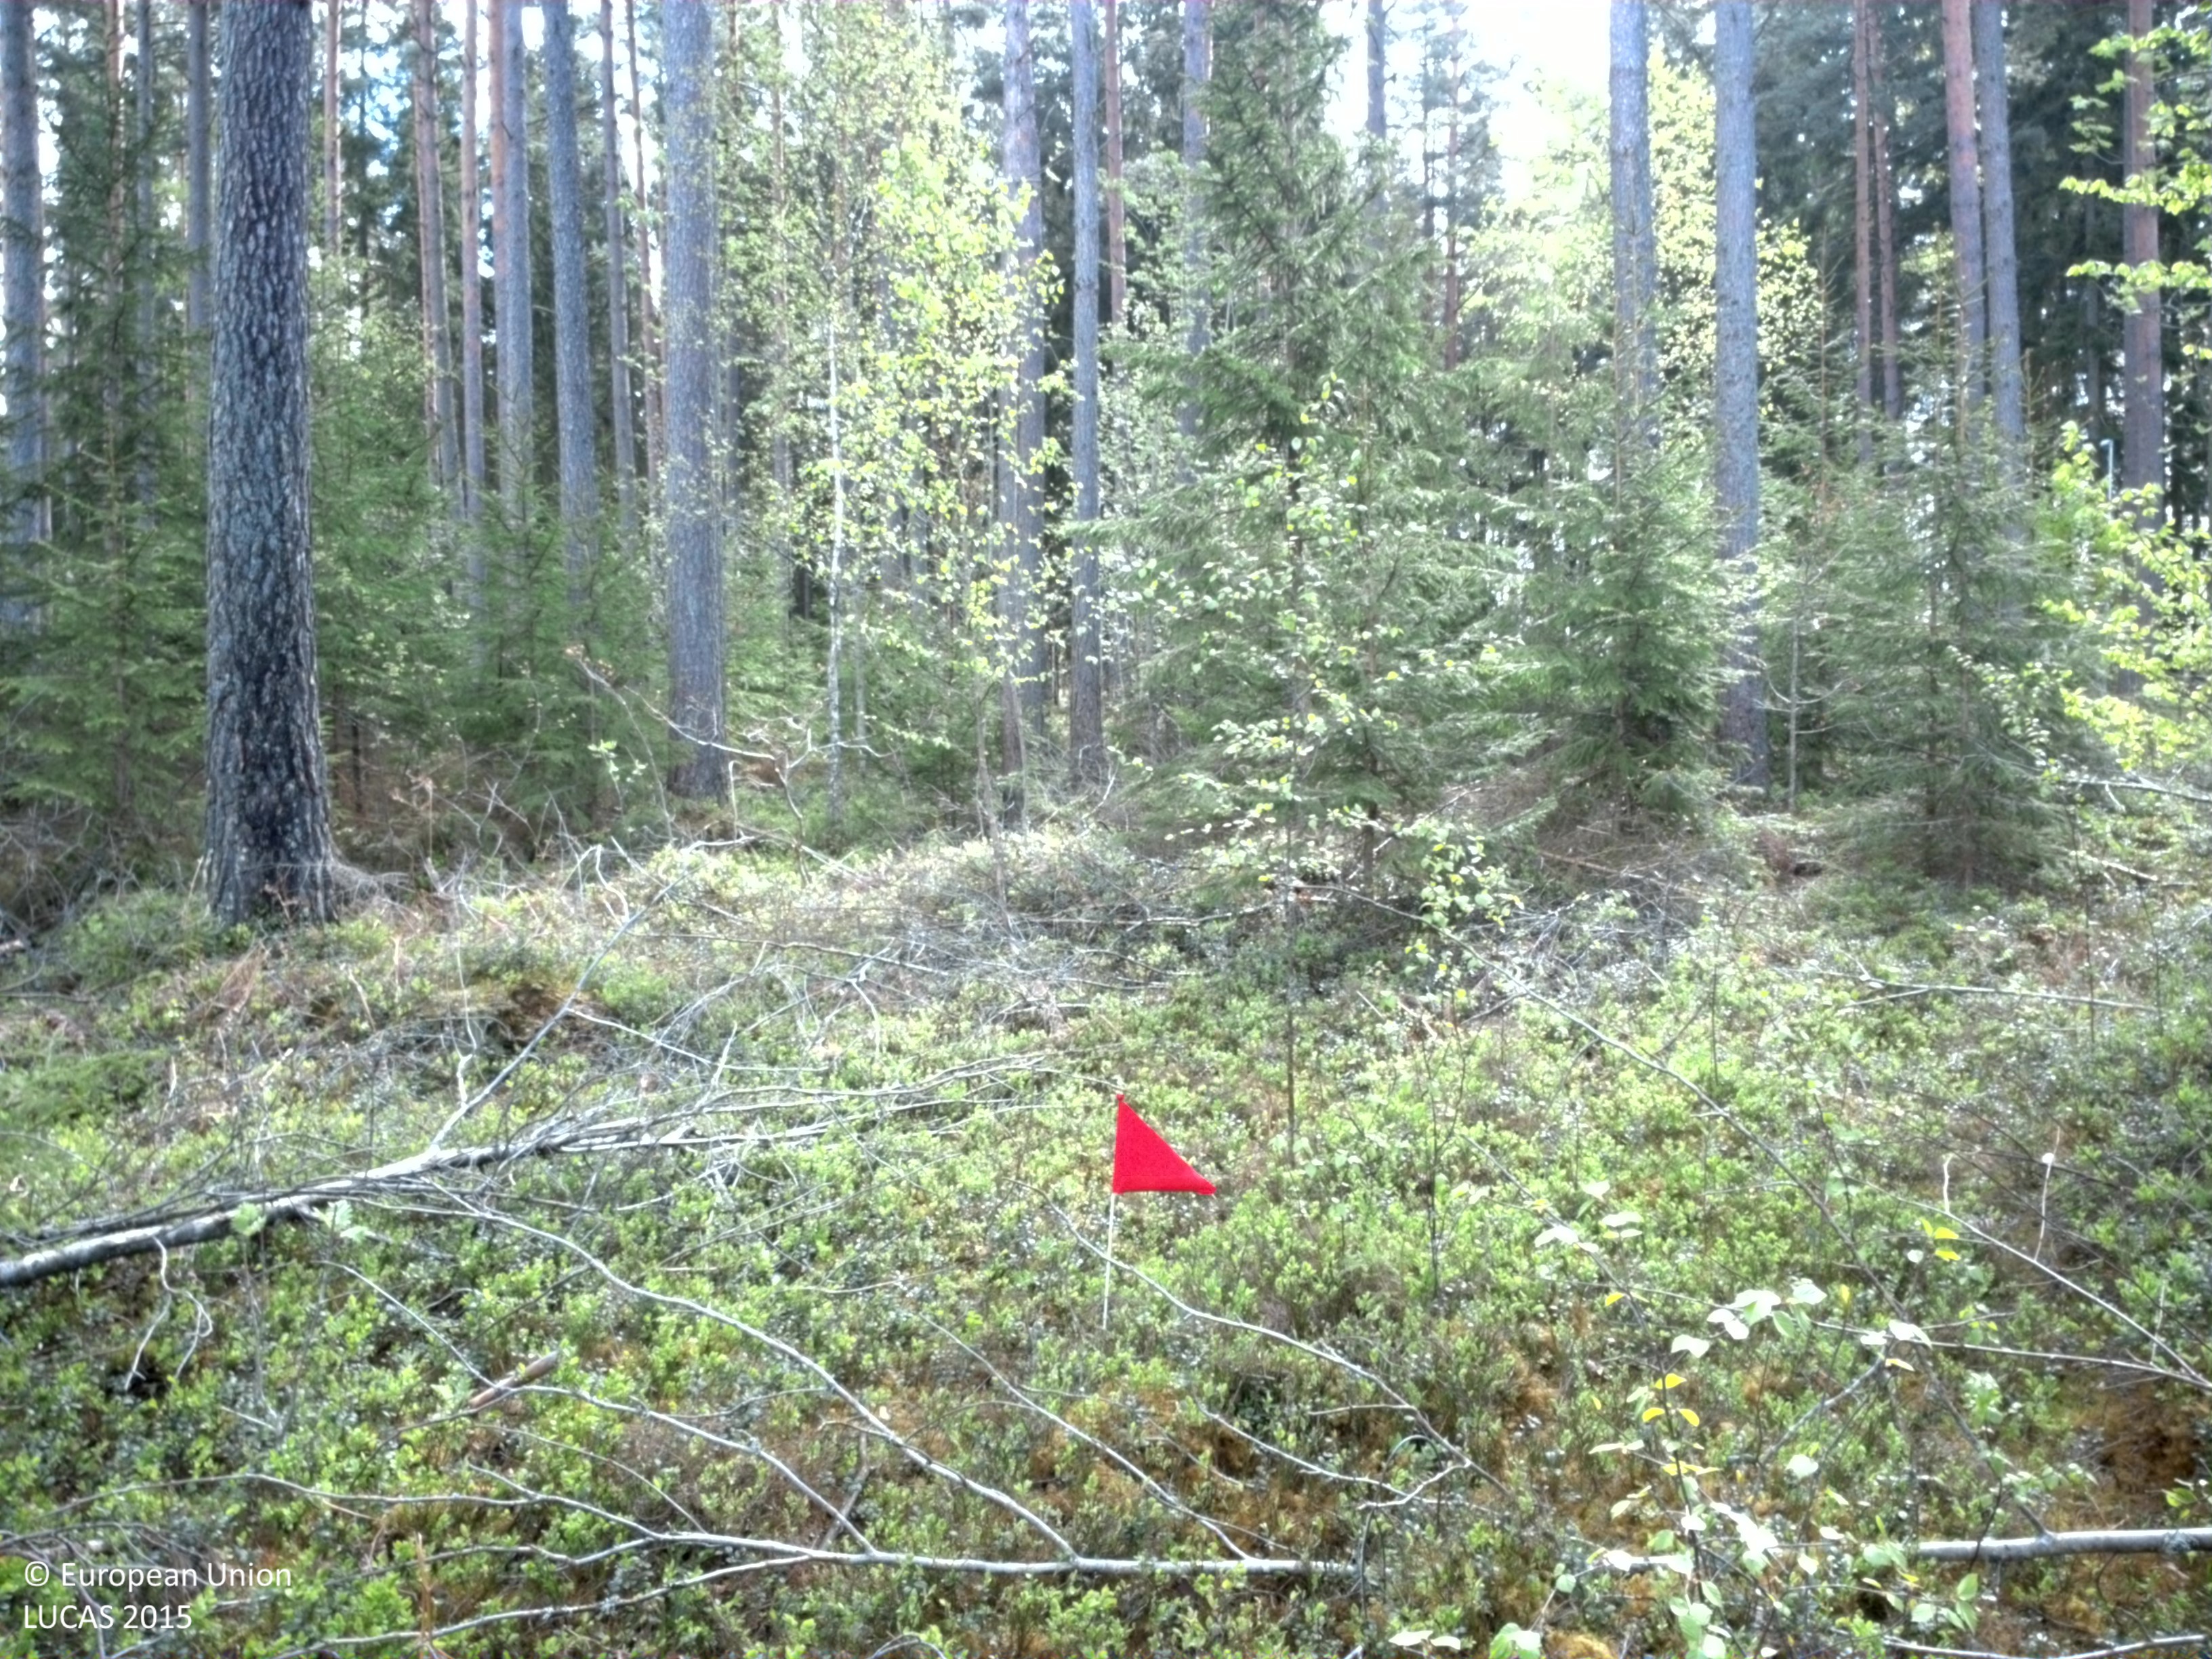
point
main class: Woodland
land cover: Pine dominated coniferous woodland
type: boreal forest
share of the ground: > 75 %
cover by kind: coniferous forest trees 60 %, broadleaved forest trees 20 %, lichens and mosses 10 %, shrubs 5 %, herbaceous plants 5 %
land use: Forestry
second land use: Amenities, museums, leisure
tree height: > 5 m
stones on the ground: < 10 %
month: May
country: SE
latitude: 56.9095
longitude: 14.7761
